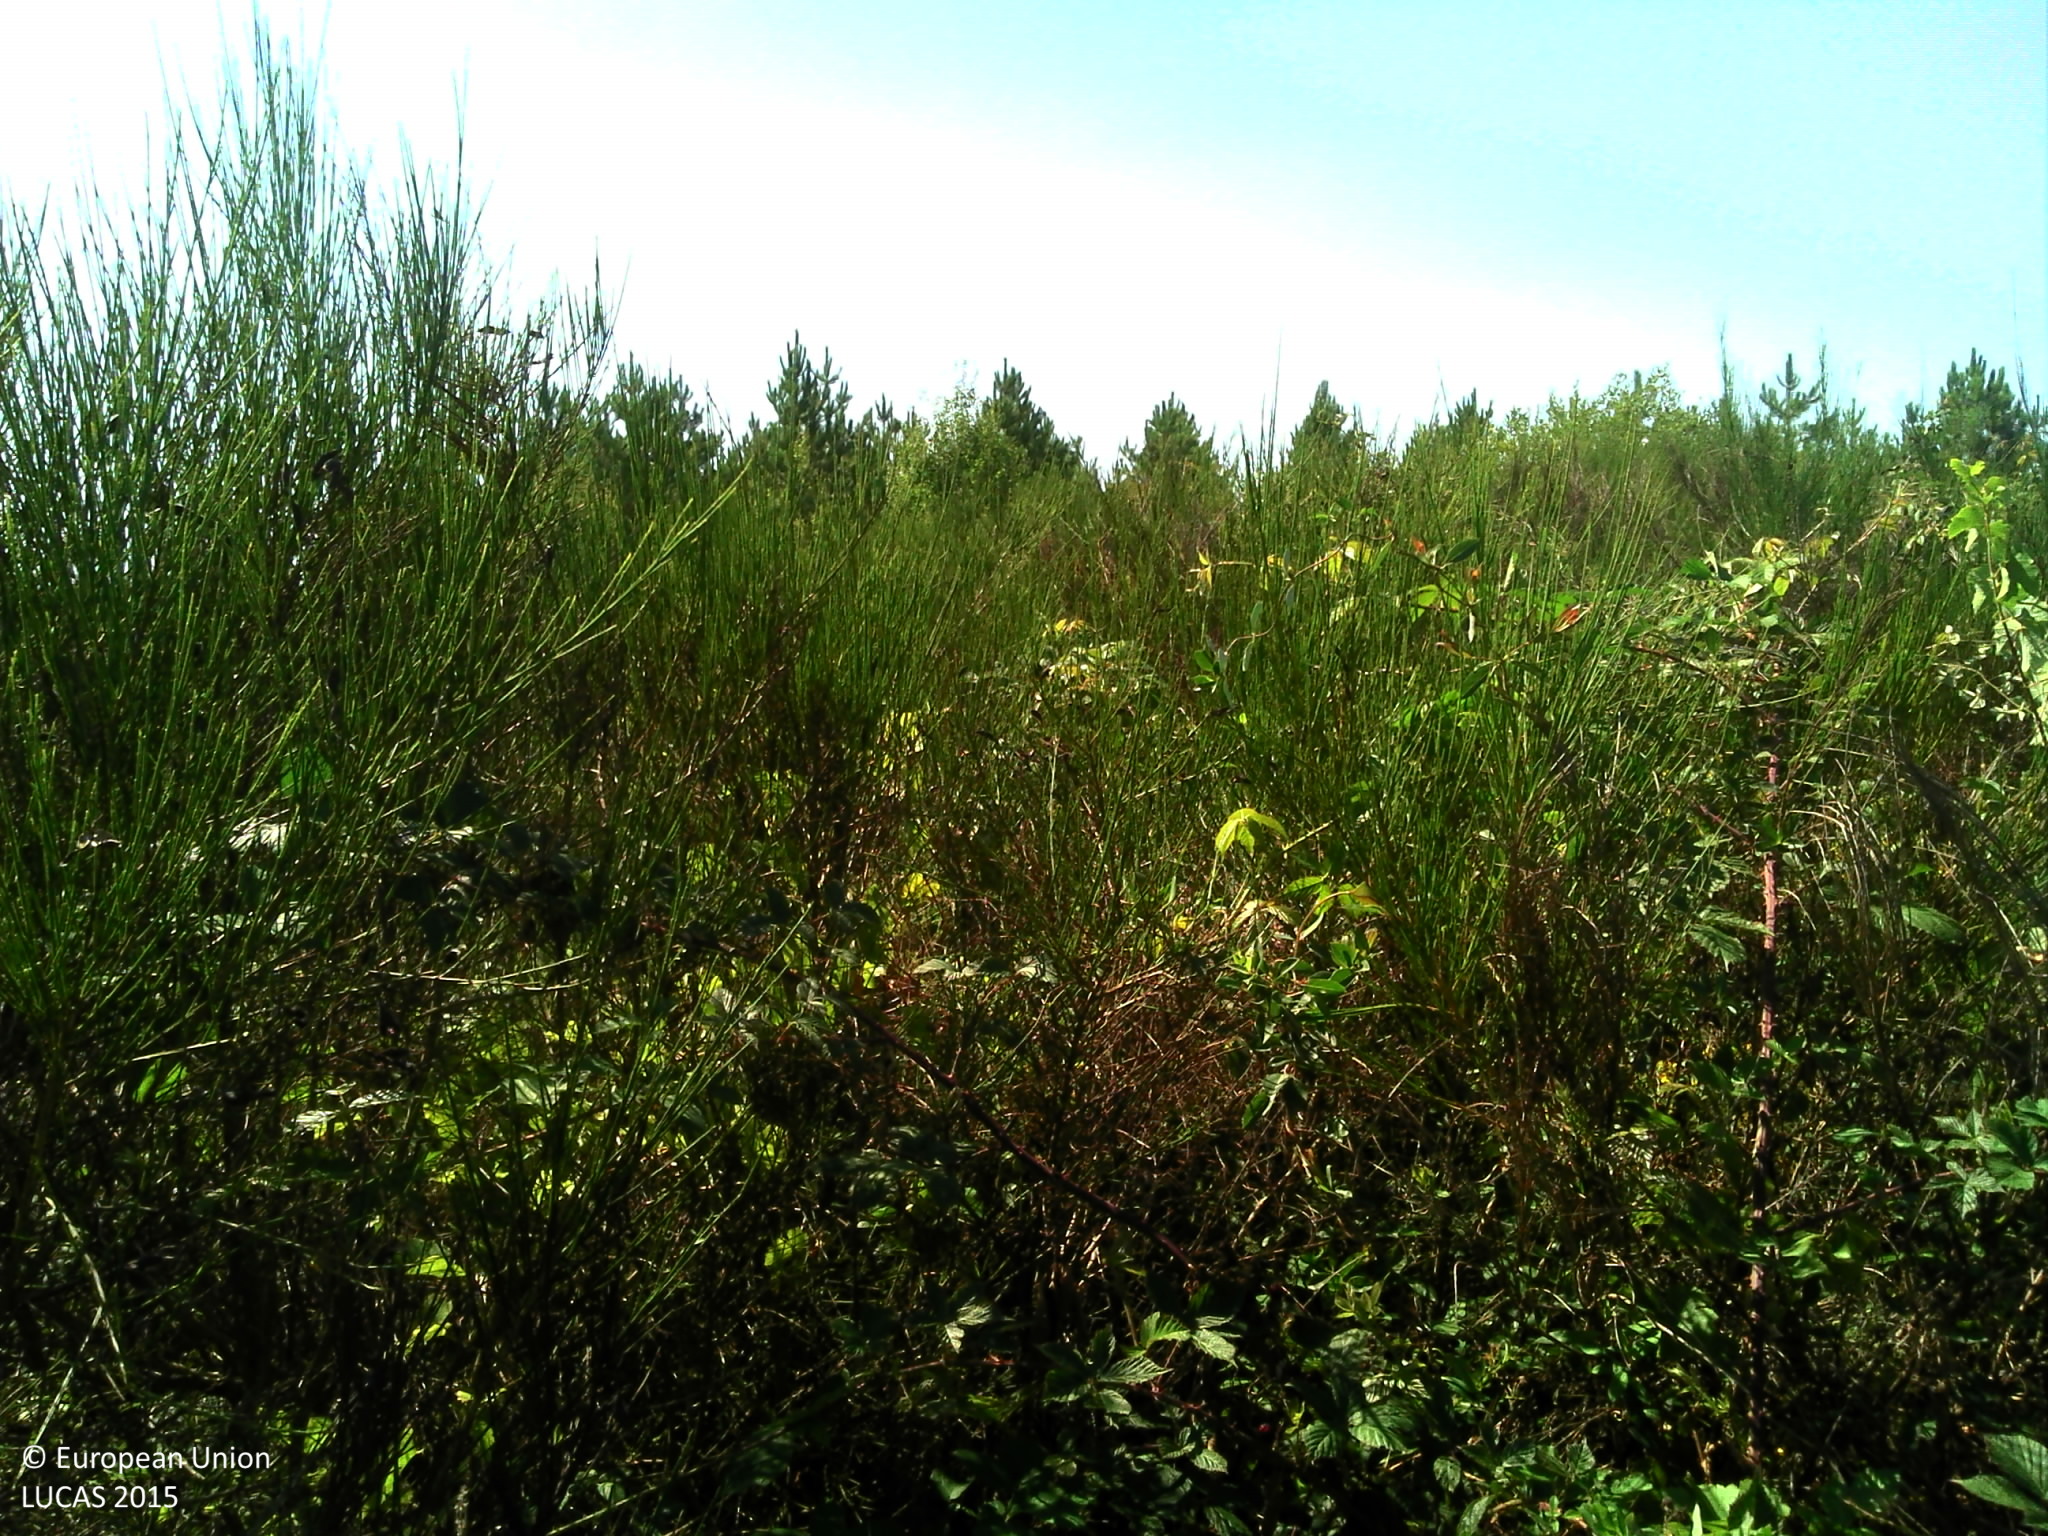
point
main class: Woodland
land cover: Pine dominated coniferous woodland
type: exotic forest
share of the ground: > 75 %
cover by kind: coniferous forest trees 70 %, shrubs 20 %, herbaceous plants 10 %
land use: Forestry
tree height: < 5 m
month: August
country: FR
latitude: 44.9813
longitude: 0.4654
